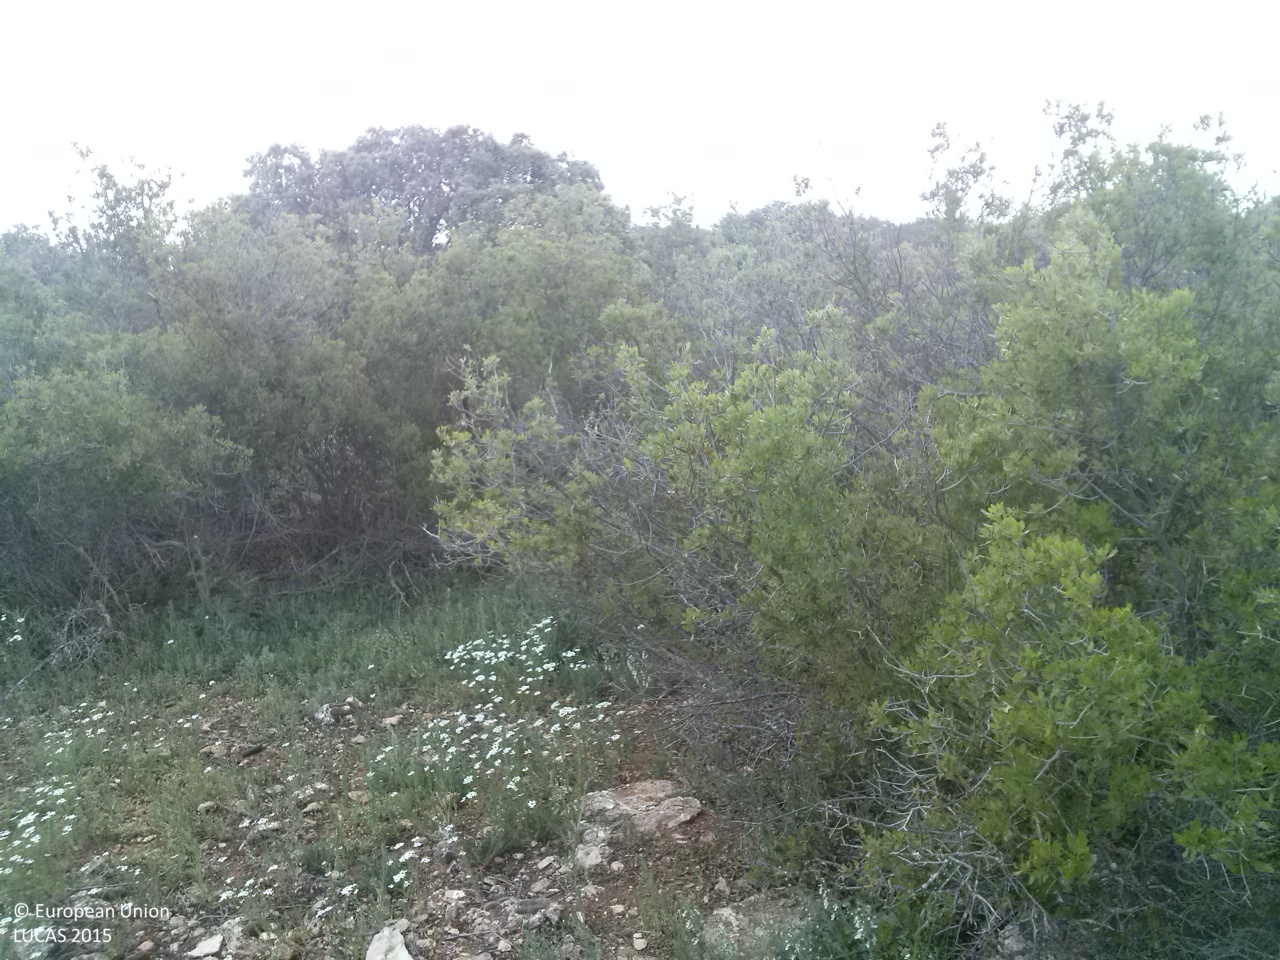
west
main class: Woodland
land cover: Broadleaved woodland
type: broadleaved evergreen forest
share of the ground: 50 - 75 %
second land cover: Grassland without tree/shrub cover
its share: 25 - 50 %
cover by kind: broadleaved forest trees 60 %, unconsolidated bare surface 20 %, herbaceous plants 15 %, shrubs 5 %
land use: Forestry
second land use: Agriculture (excluding fallow land and kitchen gardens)
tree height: < 5 m
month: May
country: ES
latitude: 39.7486
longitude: -2.8447
